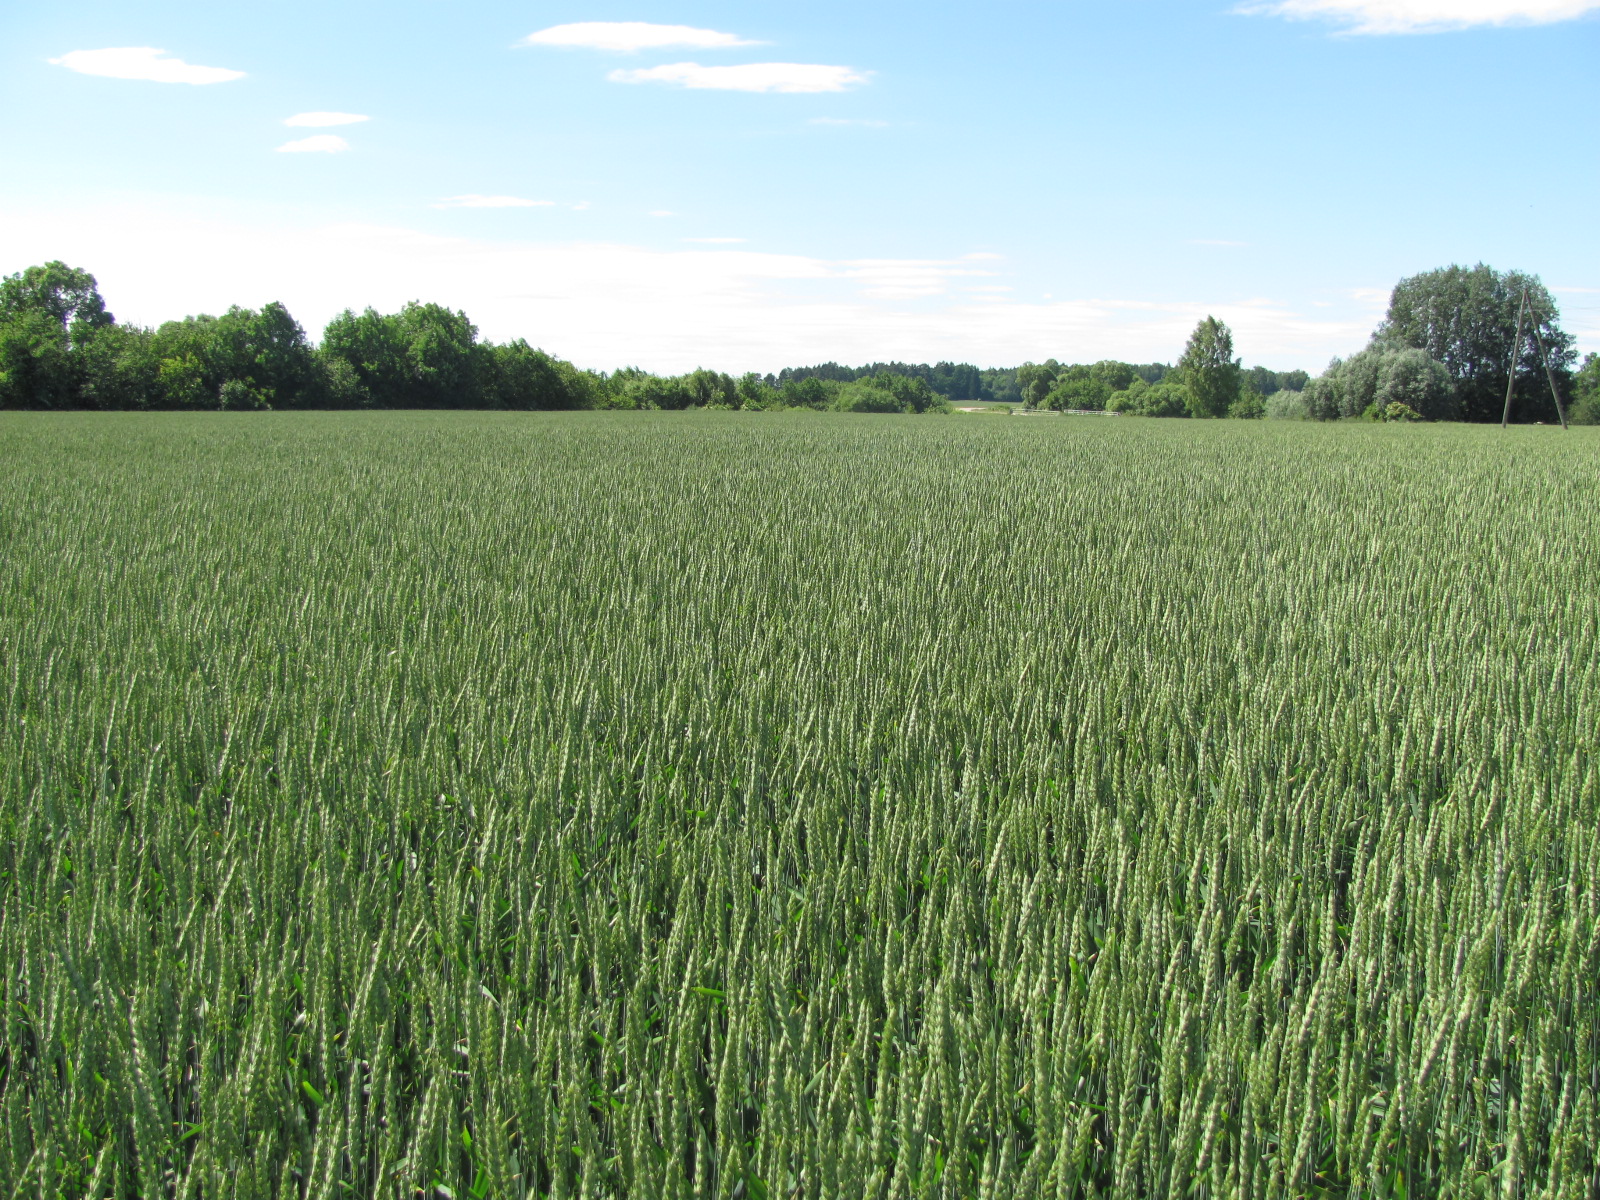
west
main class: Cropland
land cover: Common wheat
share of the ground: > 75 %
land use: Agriculture (excluding fallow land and kitchen gardens)
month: July
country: LV
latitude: 56.4471
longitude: 23.7561
